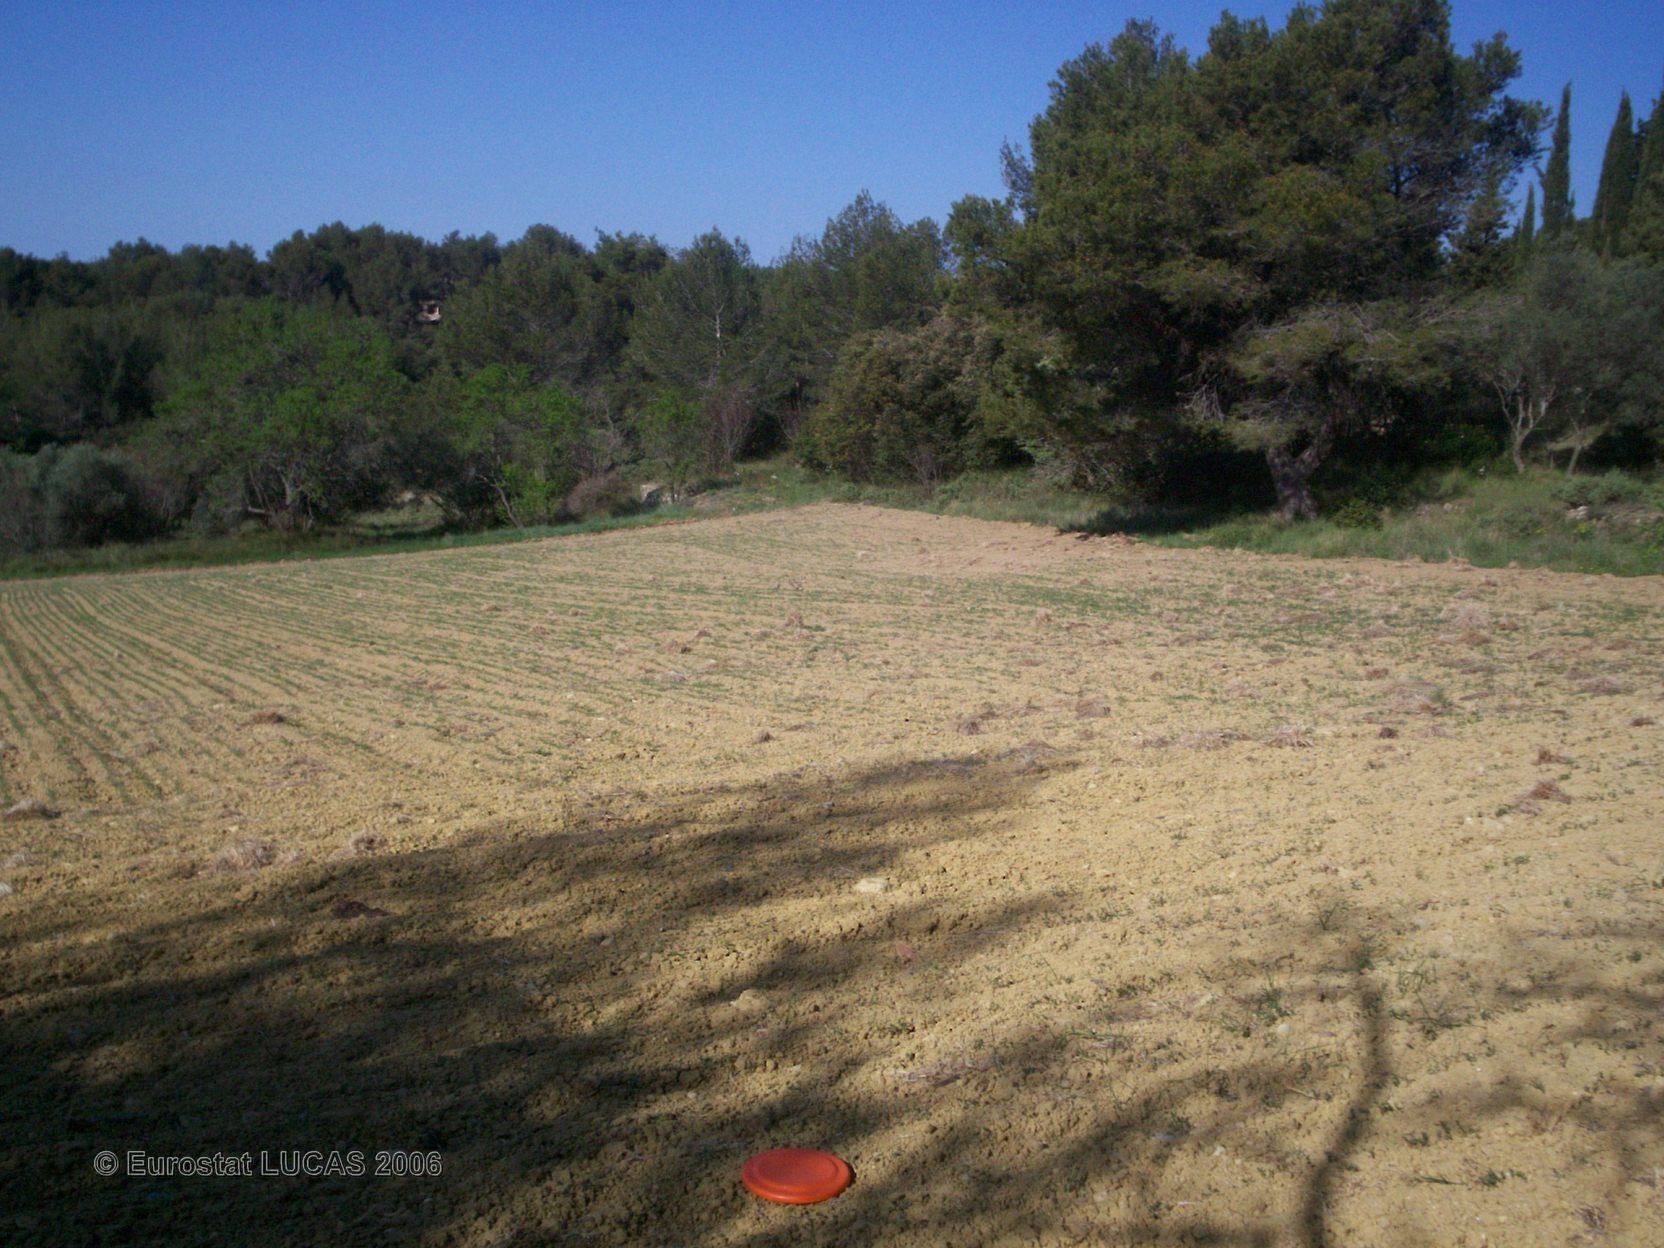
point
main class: Cropland
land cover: Other leguminous and mixtures for fodder
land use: Agriculture (excluding fallow land and kitchen gardens)
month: April
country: FR
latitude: 43.5502
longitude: 5.5412
